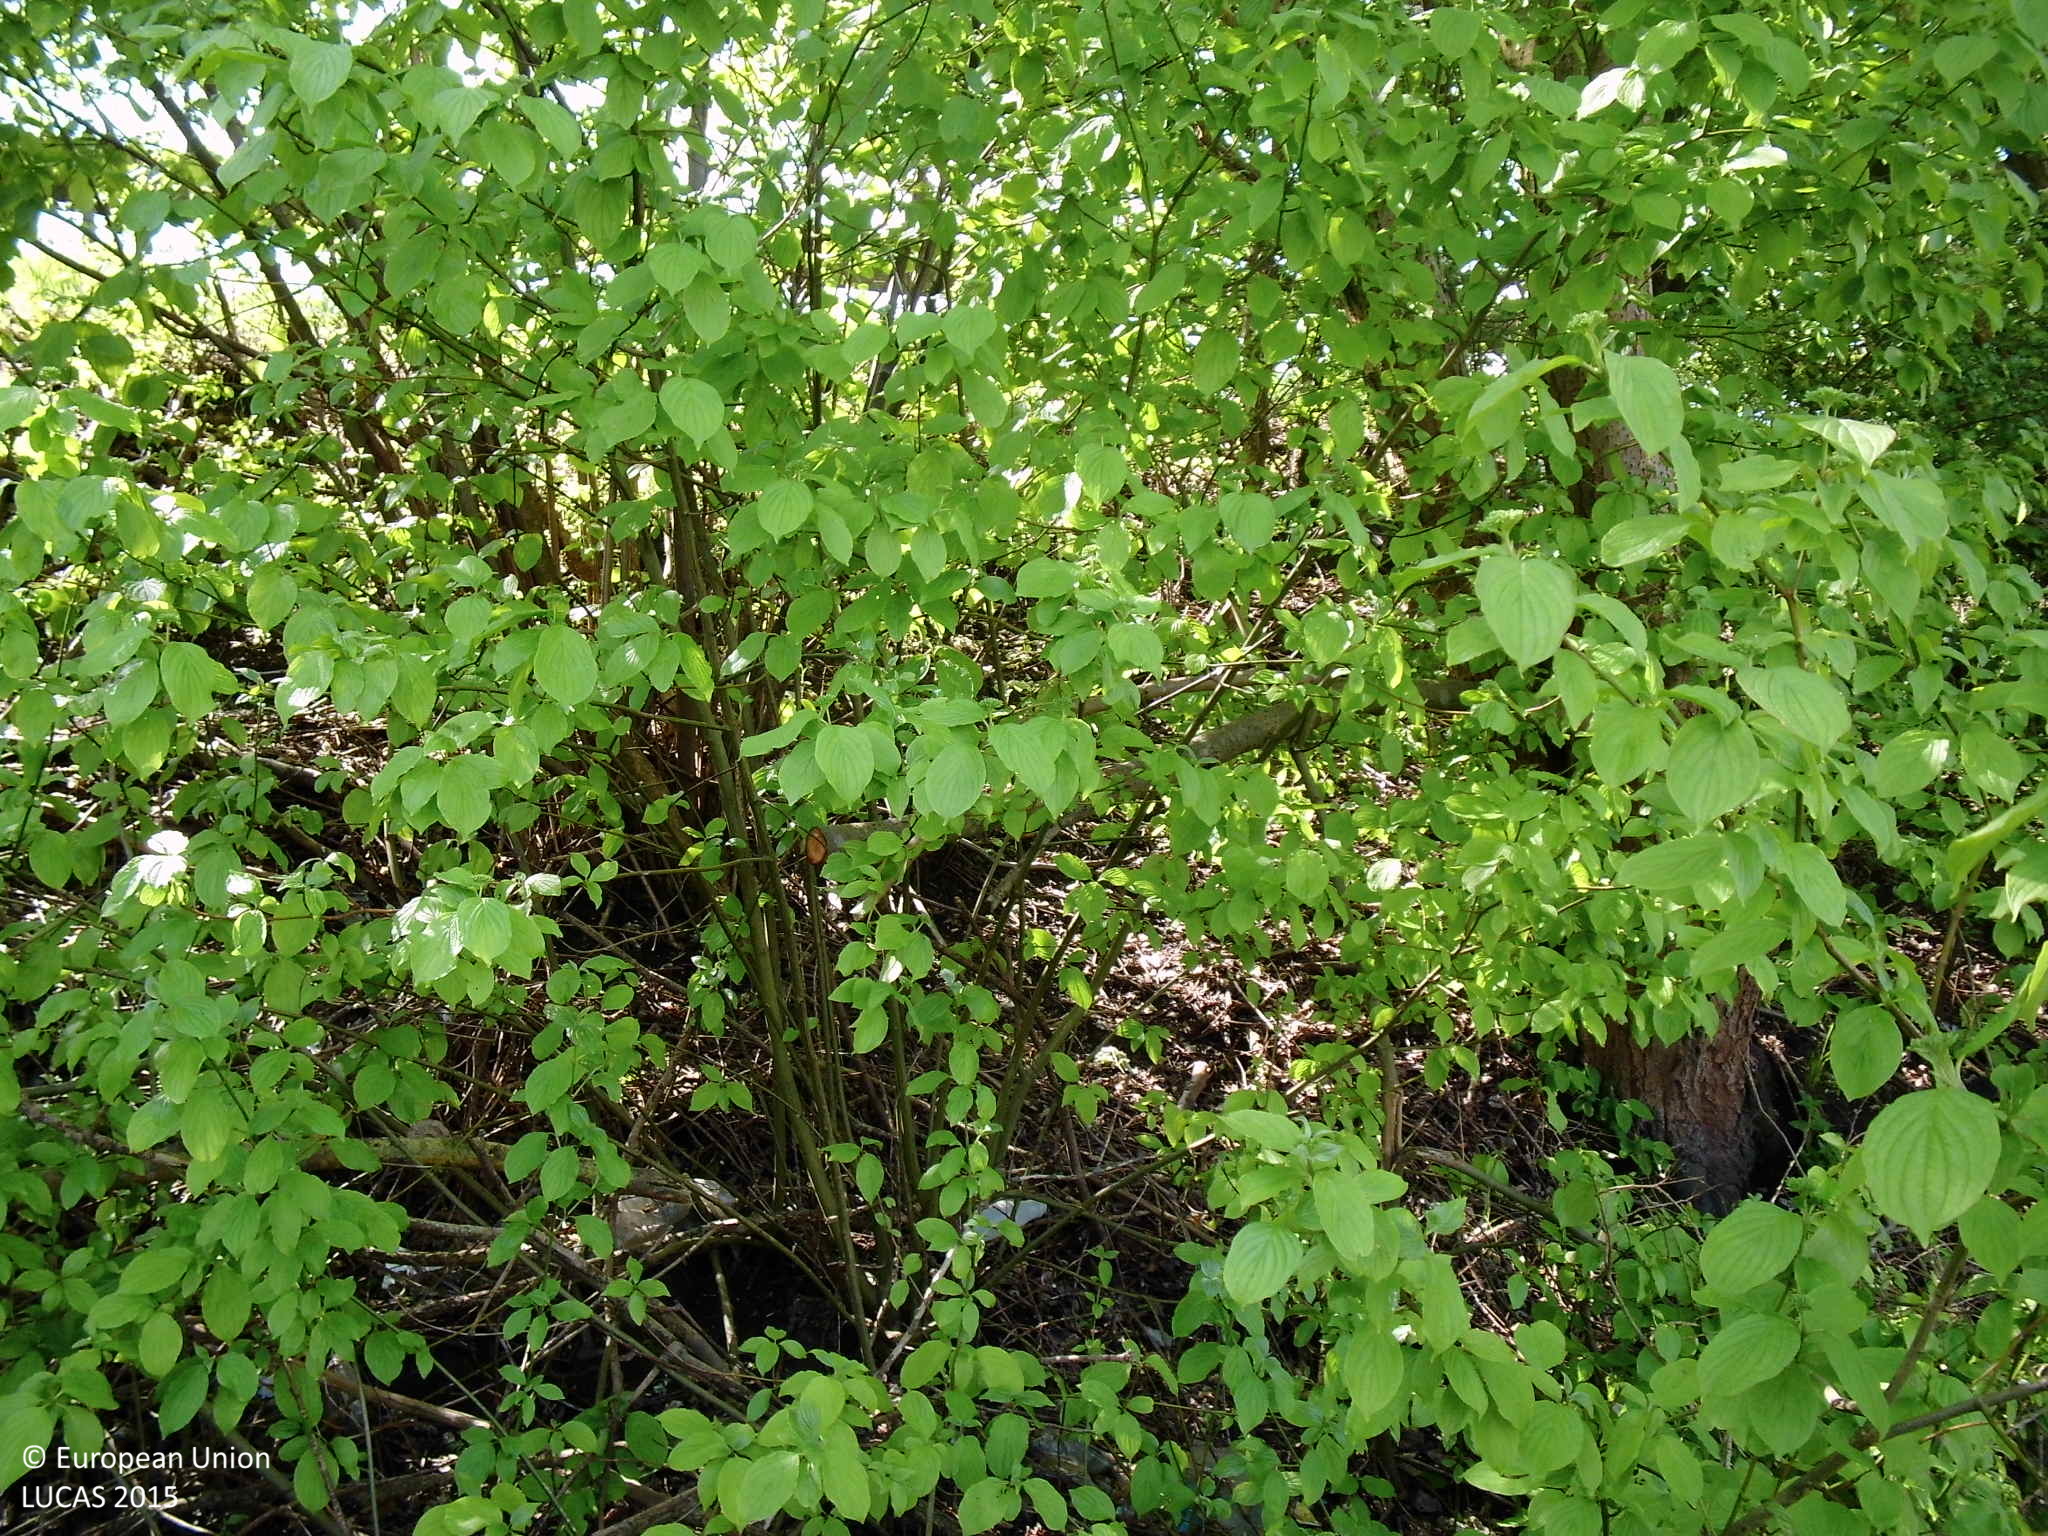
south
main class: Woodland
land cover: Broadleaved woodland
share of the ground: > 75 %
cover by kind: broadleaved forest trees 90 %, herbaceous plants 5 %, unconsolidated bare surface 5 %
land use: Road transport
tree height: > 5 m
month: May
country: DE
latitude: 51.5215
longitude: 7.3916
